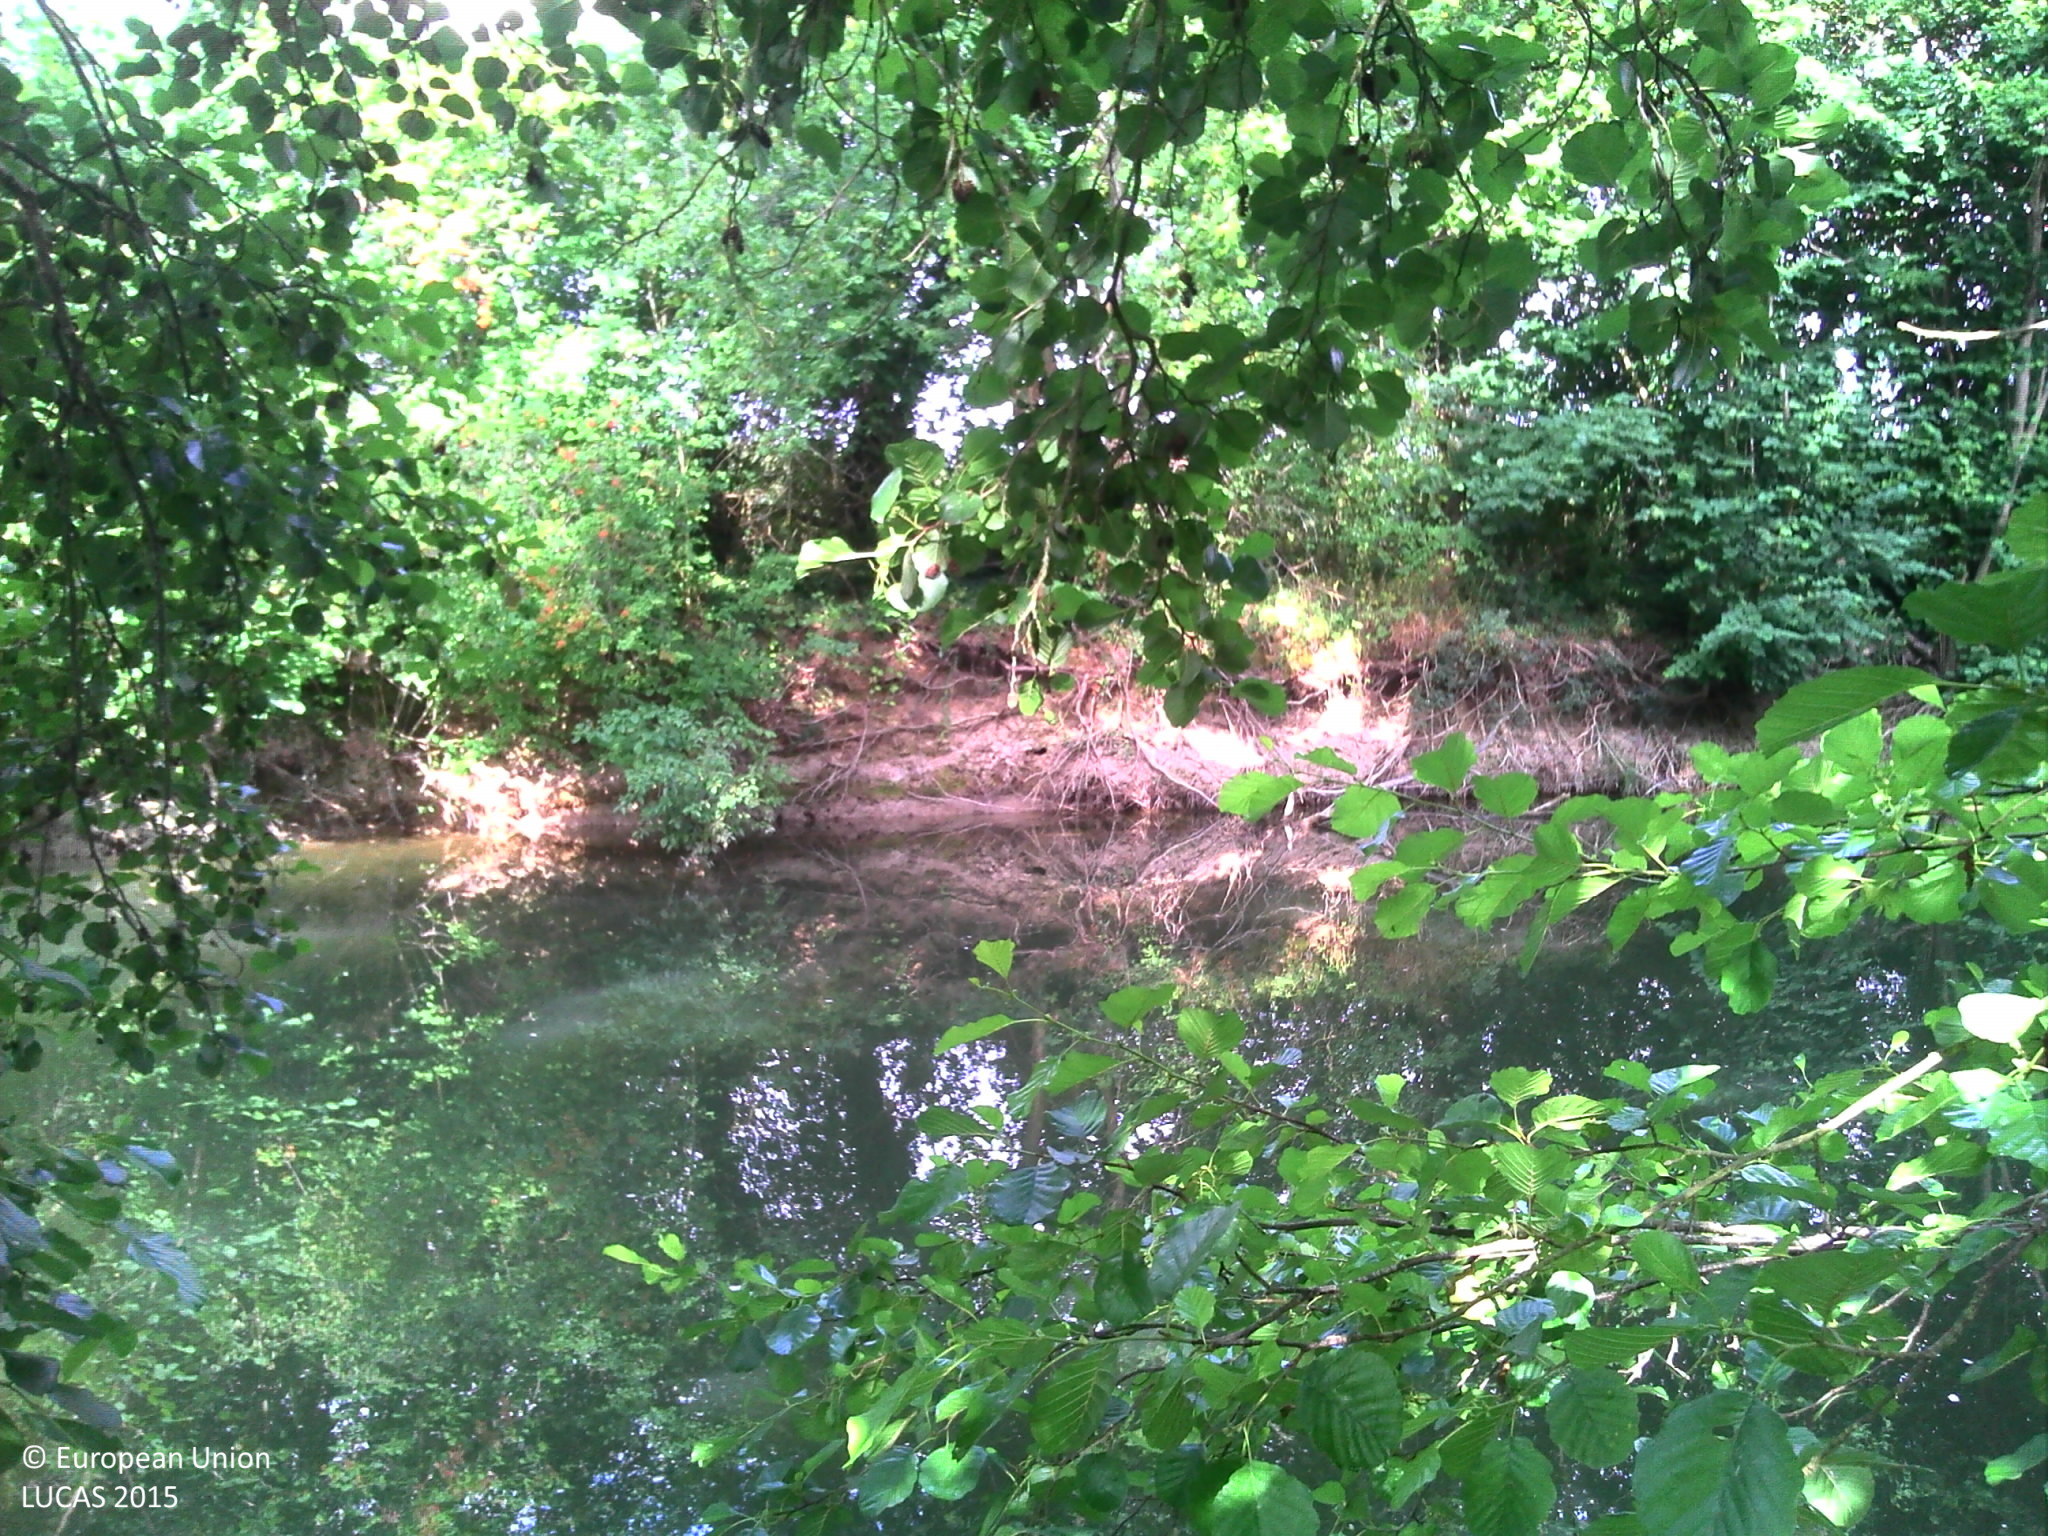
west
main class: Woodland
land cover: Broadleaved woodland
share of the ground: > 75 %
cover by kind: broadleaved forest trees 95 %, herbaceous plants 5 %
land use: Semi-natural and natural areas not in use
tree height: > 5 m
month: July
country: FR
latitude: 49.2116
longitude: 5.0423
